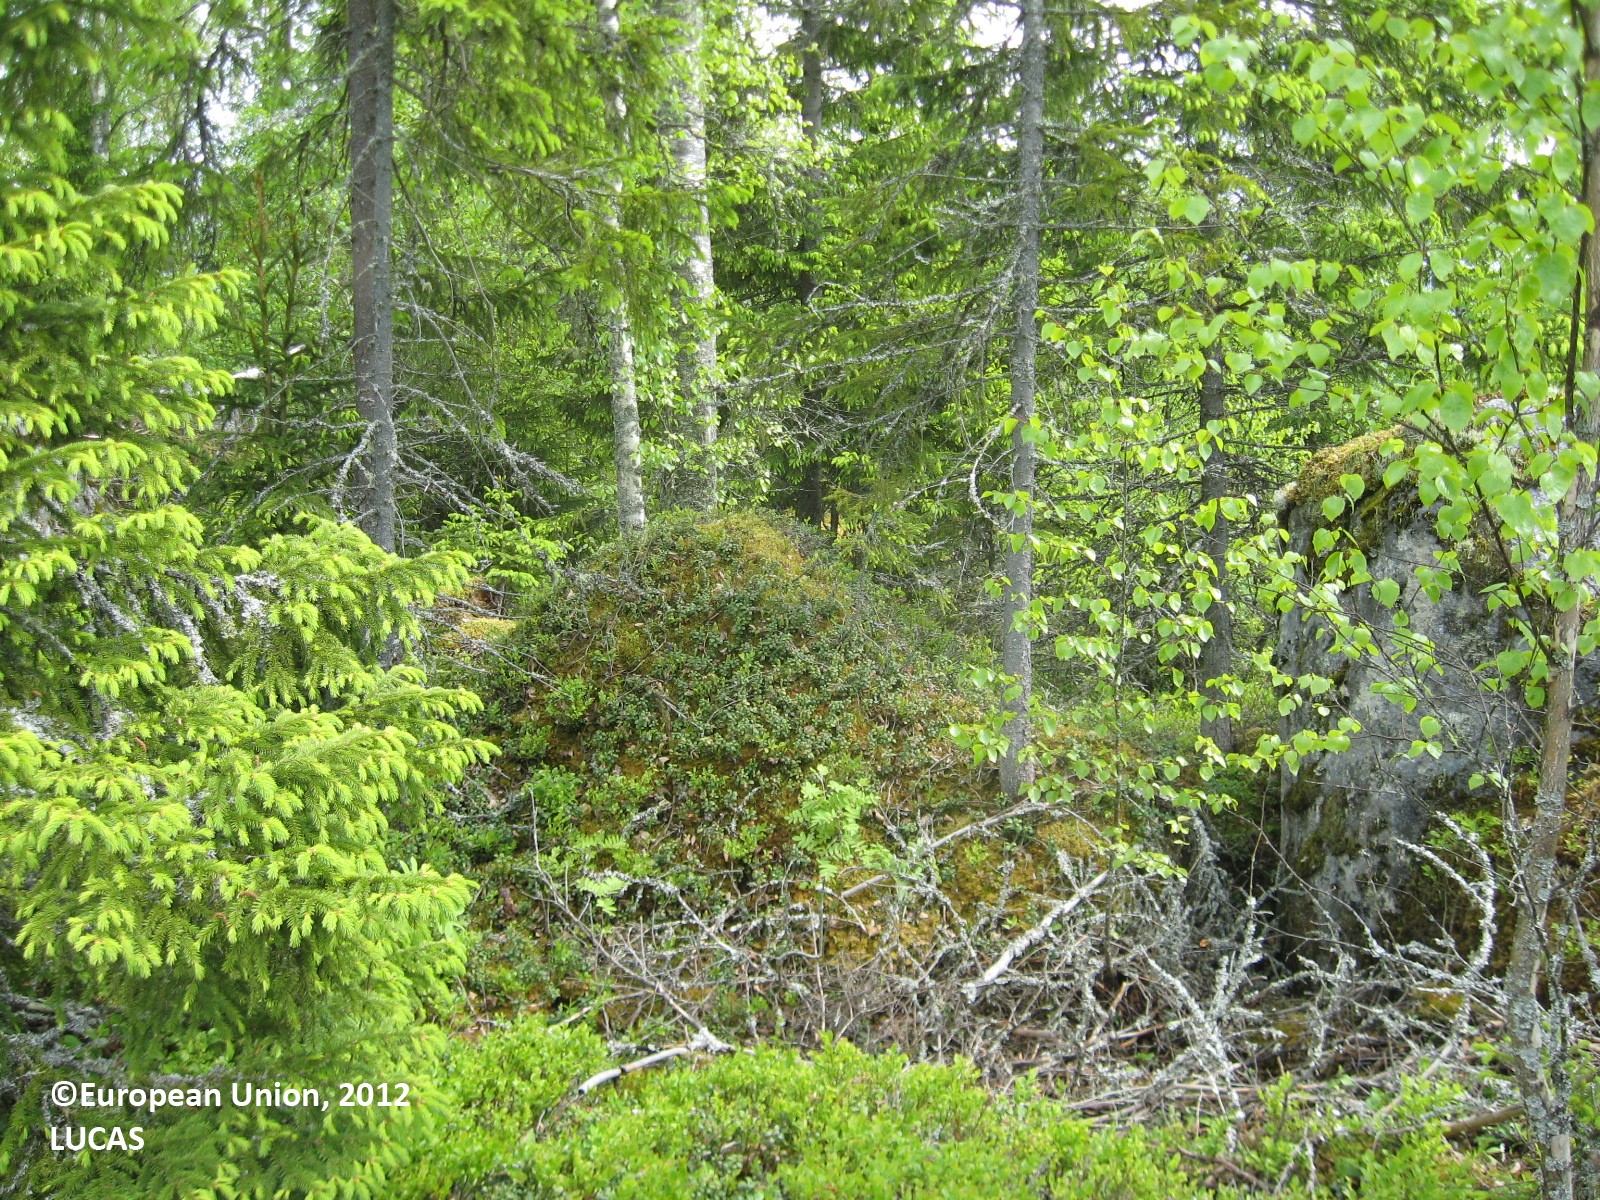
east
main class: Woodland
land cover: Spruce dominated mixed woodland
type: boreal forest
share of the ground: > 75 %
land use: Forestry
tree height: > 5 m
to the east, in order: Spruce dominated mixed woodland; Other mixed woodland; Ditches and canals; Barley; Electric lines; Barley
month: June
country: FI
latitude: 63.0562
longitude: 21.8527
